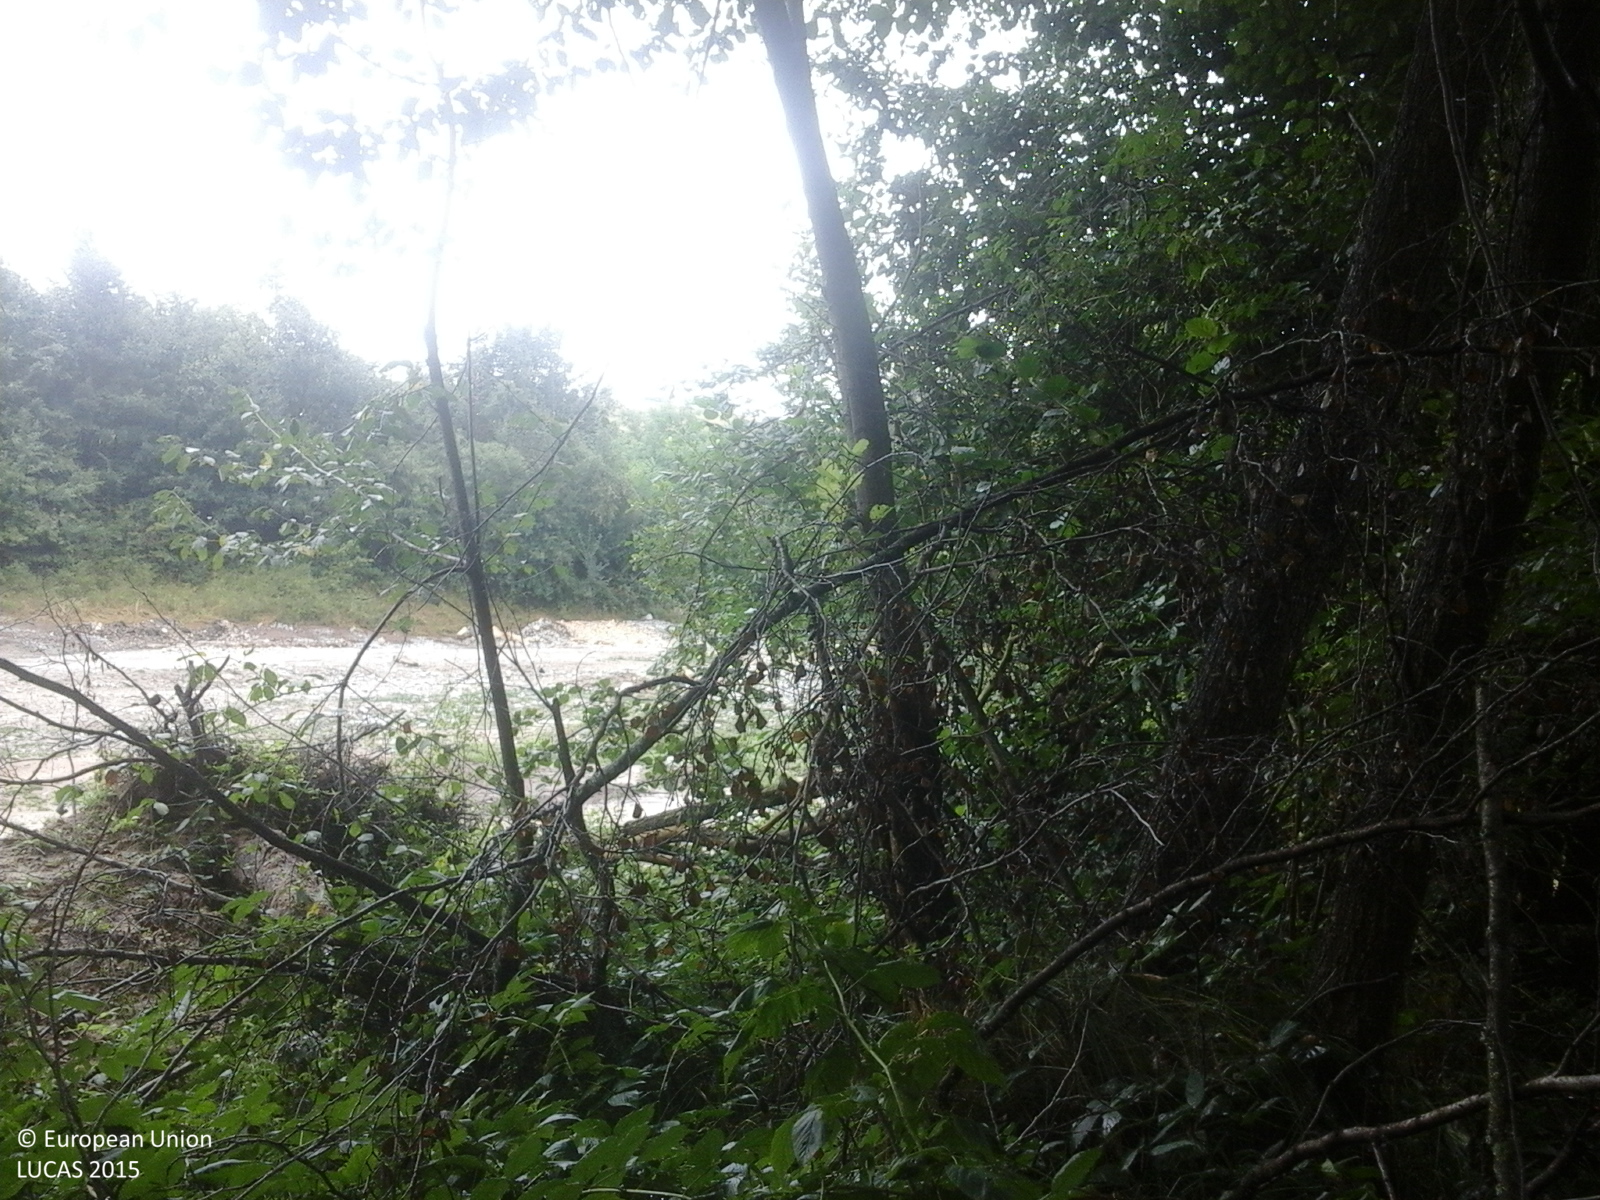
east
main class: Woodland
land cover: Broadleaved woodland
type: thermophilous deciduous forest
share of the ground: > 75 %
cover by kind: broadleaved forest trees 100 %
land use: Forestry
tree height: > 5 m
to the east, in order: Broadleaved woodland; Grassland without tree/shrub cover; Broadleaved woodland
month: August
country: RO
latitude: 44.9999
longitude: 22.1522
